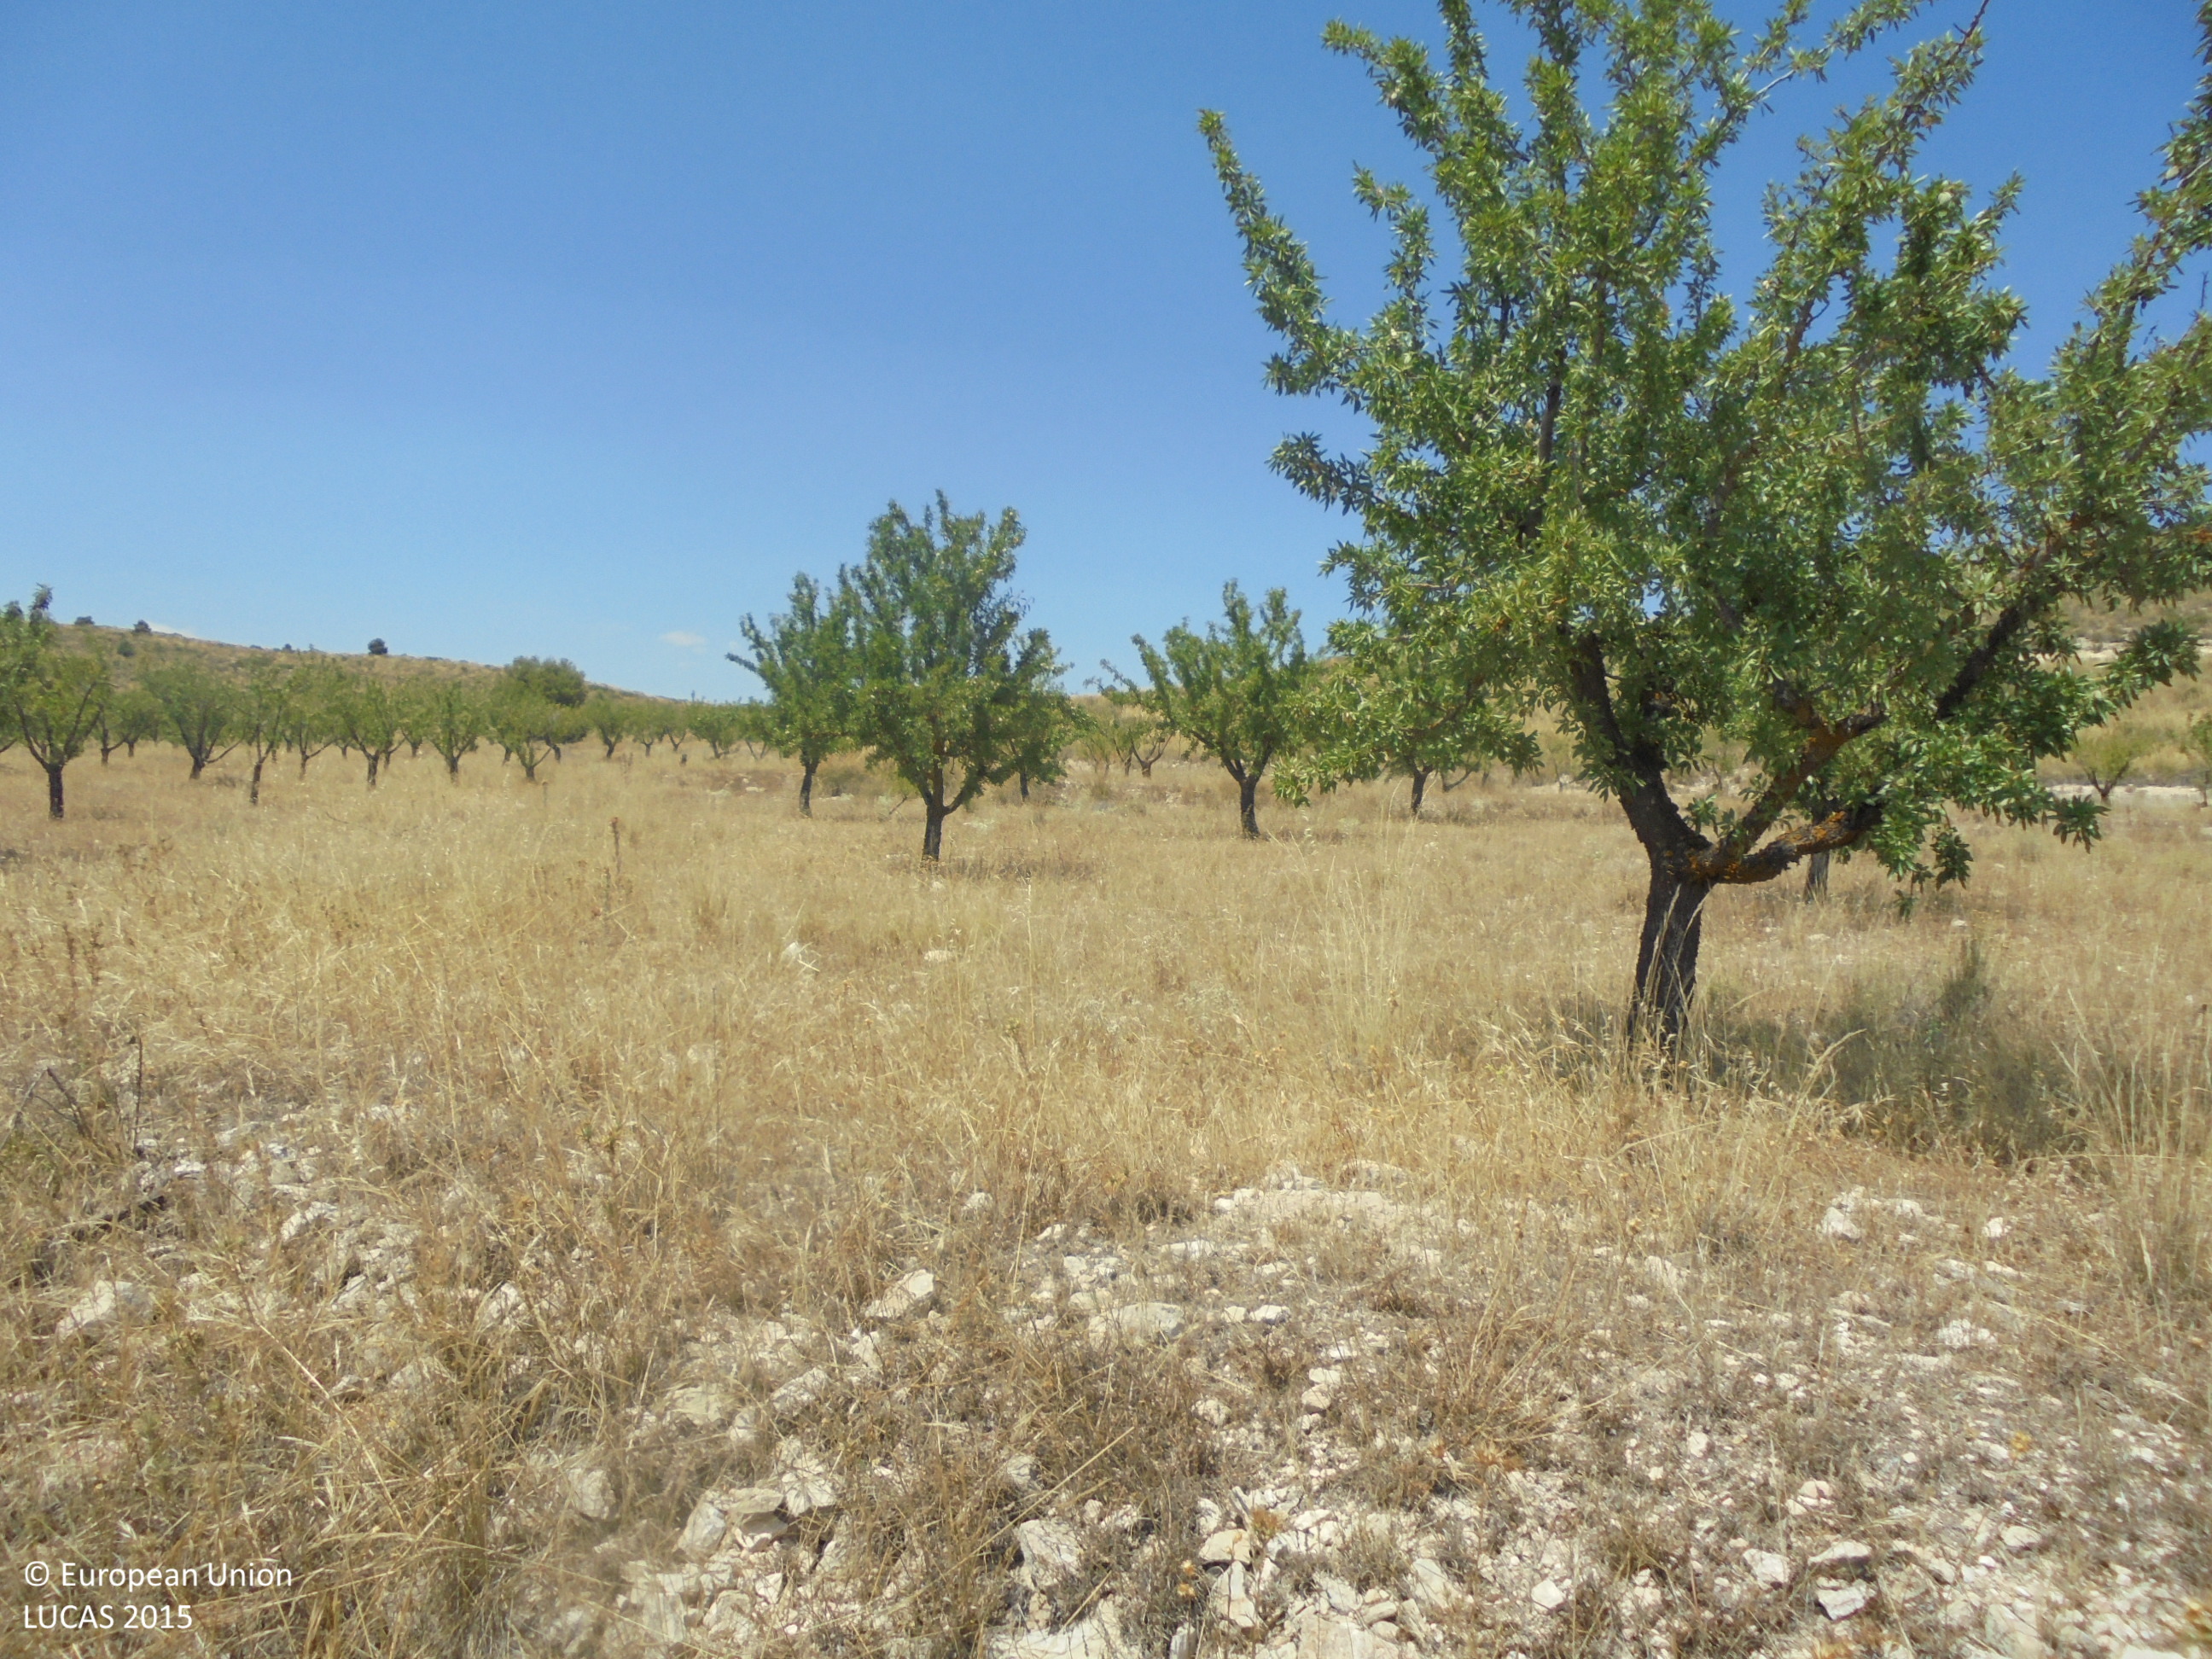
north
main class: Shrubland
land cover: Shrubland without tree cover
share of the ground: > 75 %
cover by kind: shrubs 90 %, unconsolidated bare surface 10 %
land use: Abandoned areas
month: July
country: ES
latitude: 38.7345
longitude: -1.4639
